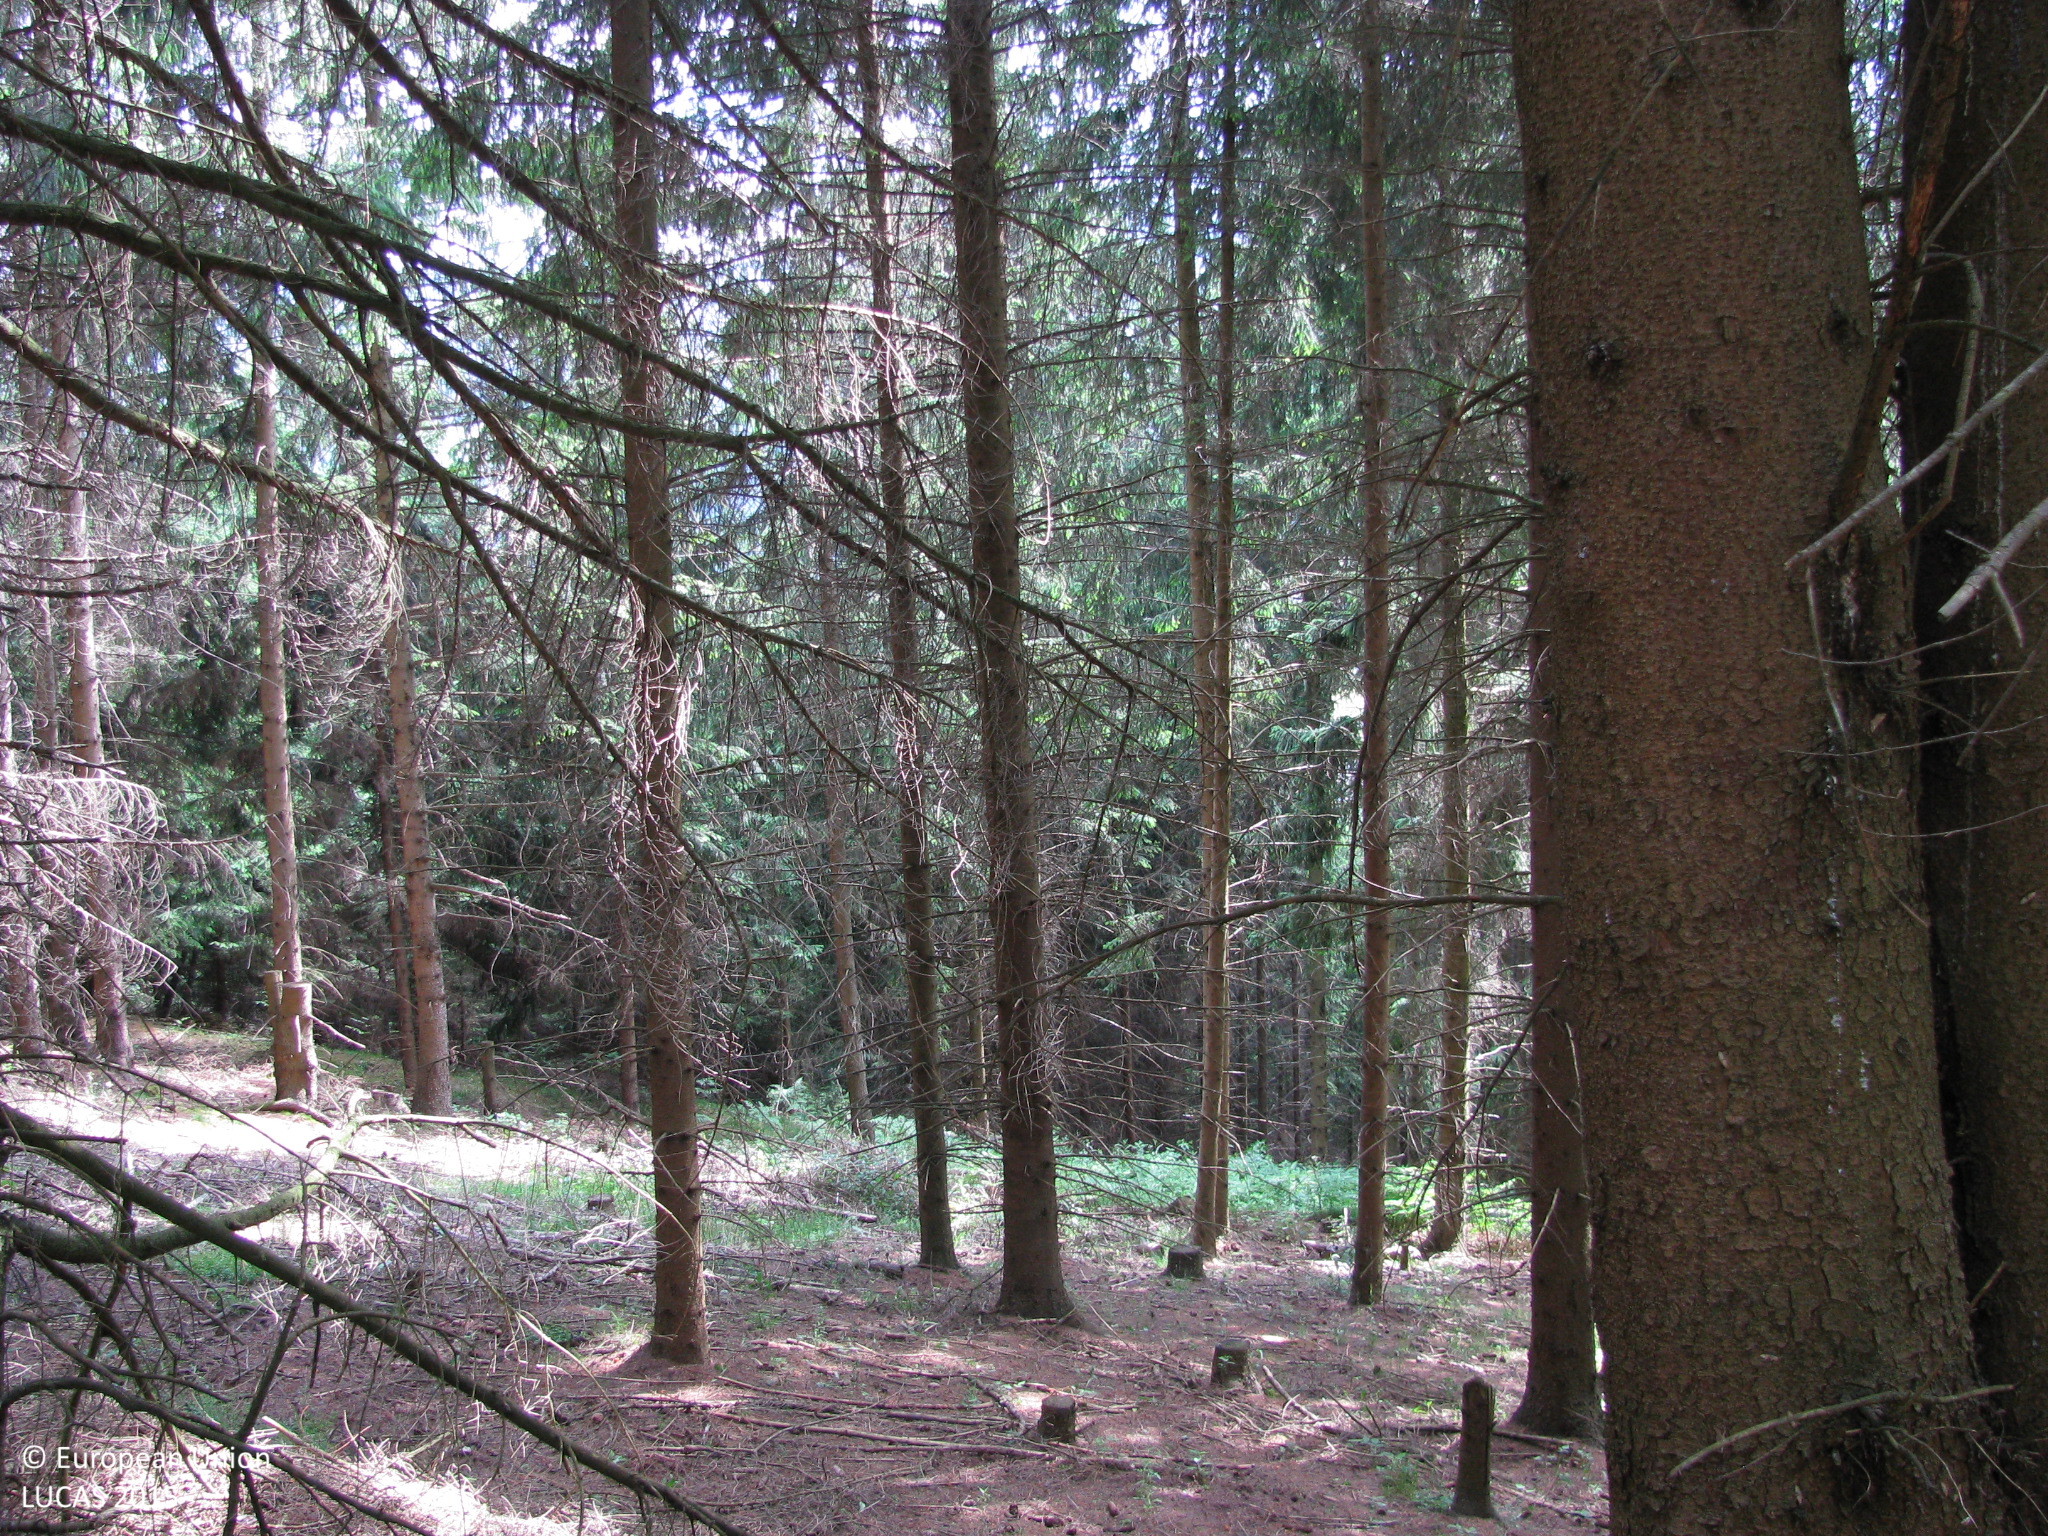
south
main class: Woodland
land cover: Spruce dominated coniferous woodland
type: alpine coniferous forest
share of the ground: > 75 %
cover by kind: coniferous forest trees 85 %, herbaceous plants 5 %, lichens and mosses 5 %, unconsolidated bare surface 5 %
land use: Forestry
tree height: > 5 m
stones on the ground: < 10 %
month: June
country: AT
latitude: 47.3916
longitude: 14.9411
